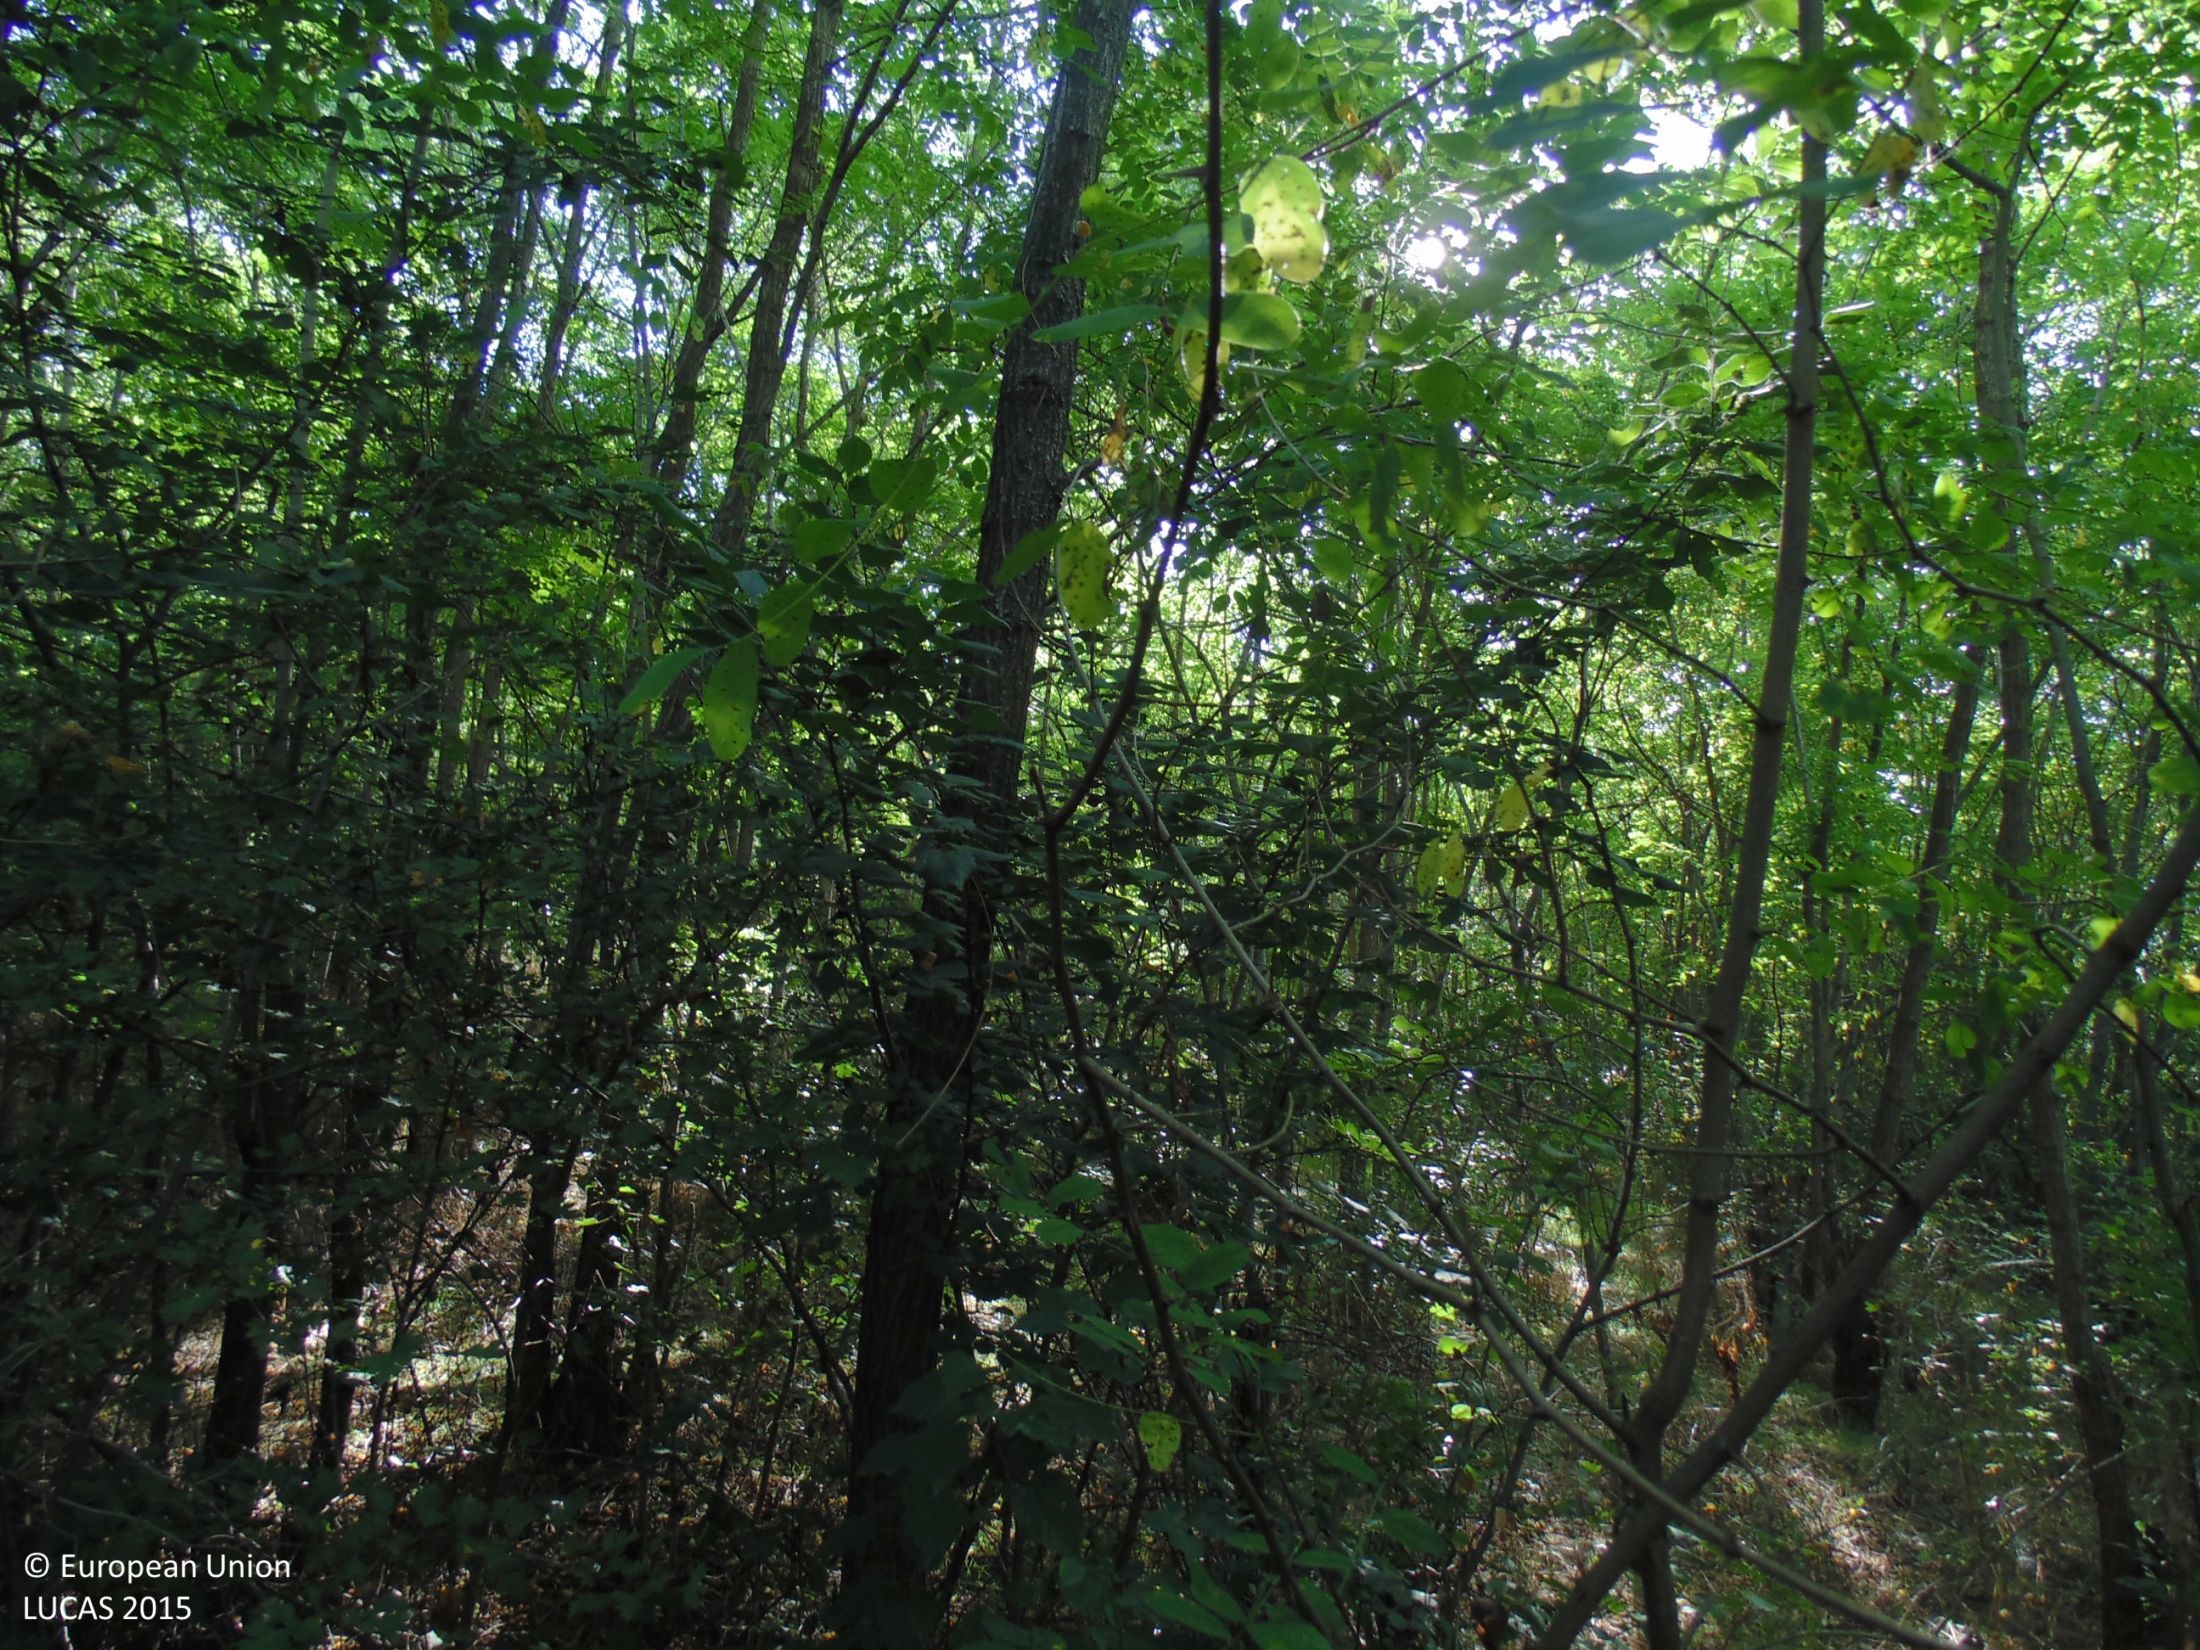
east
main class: Woodland
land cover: Broadleaved woodland
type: mesophytic deciduous forest
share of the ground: > 75 %
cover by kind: broadleaved forest trees 90 %, shrubs 5 %, unconsolidated bare surface 5 %
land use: Forestry
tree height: > 5 m
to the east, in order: Broadleaved woodland; Grassland with sparse tree/shrub cover; Broadleaved woodland
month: September
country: BG
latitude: 43.8384
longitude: 27.1009
